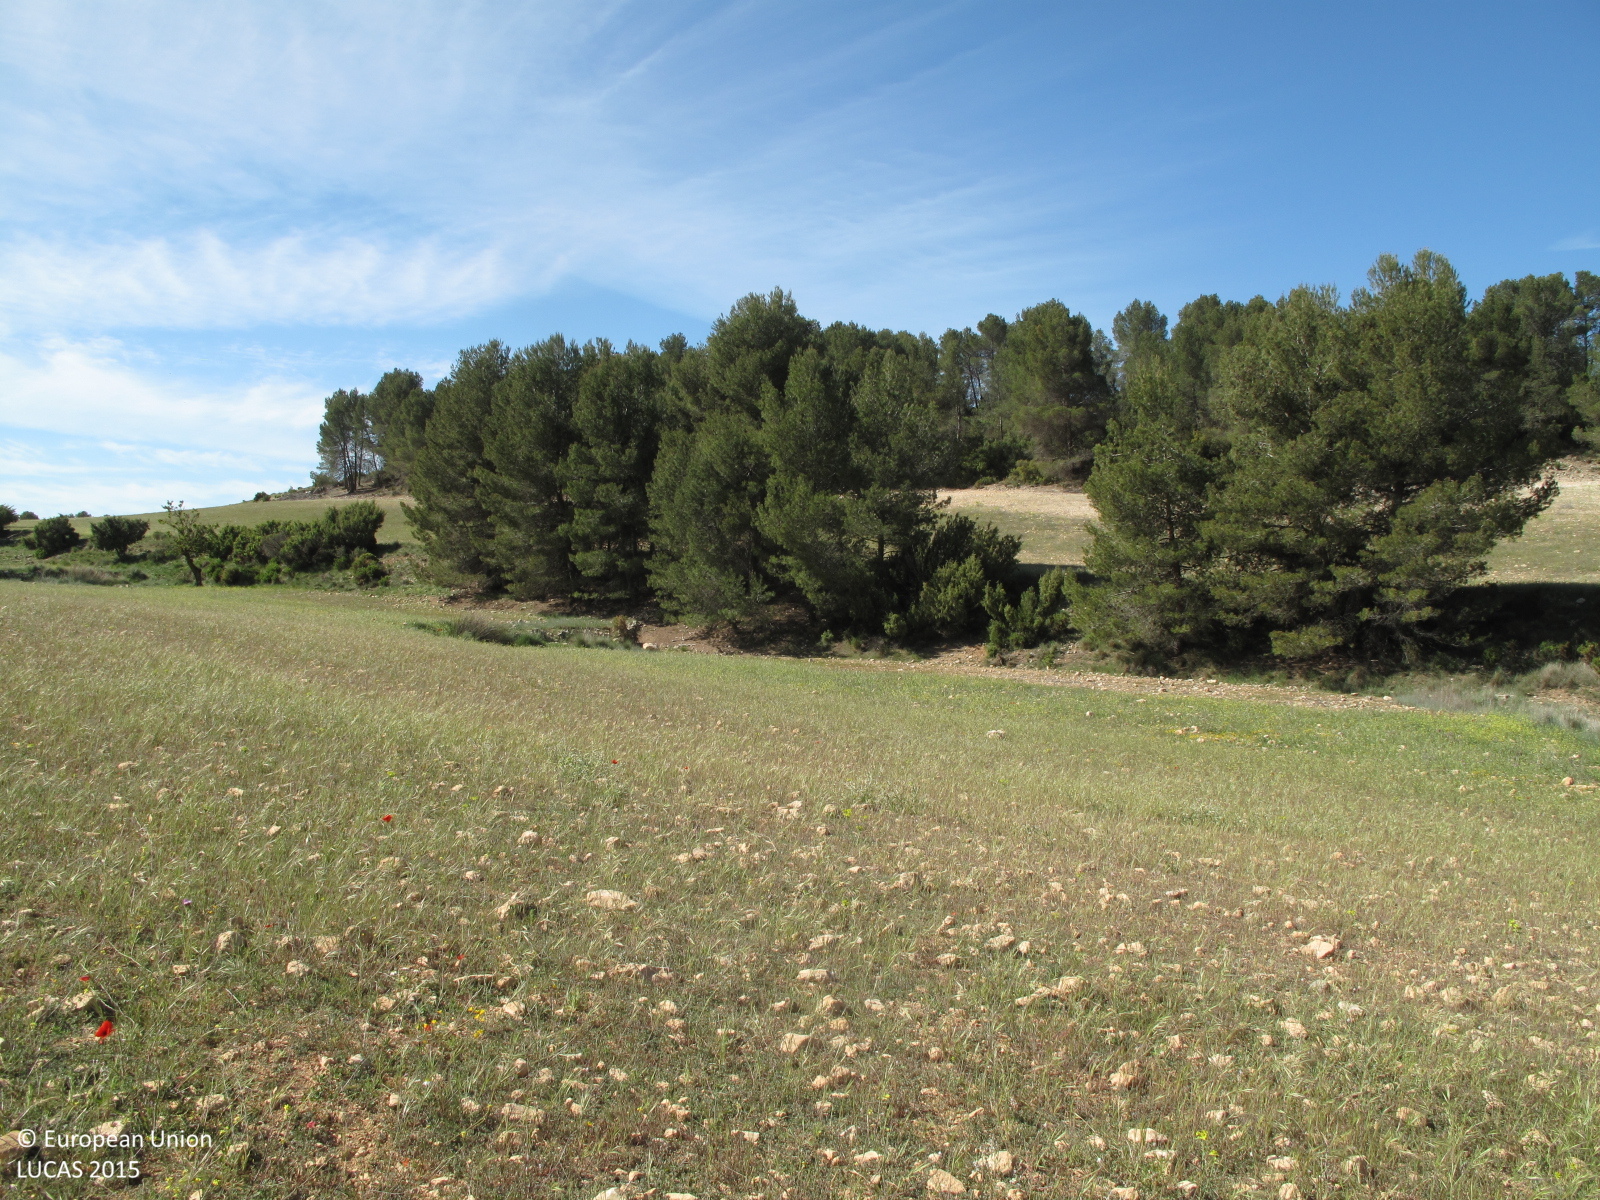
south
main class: Grassland
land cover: Spontaneously vegetated surfaces
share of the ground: 50 - 75 %
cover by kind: herbaceous plants 70 %, unconsolidated bare surface 30 %
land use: Fallow land
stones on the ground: 25 - 50 %
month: May
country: ES
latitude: 38.8978
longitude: -1.0053
